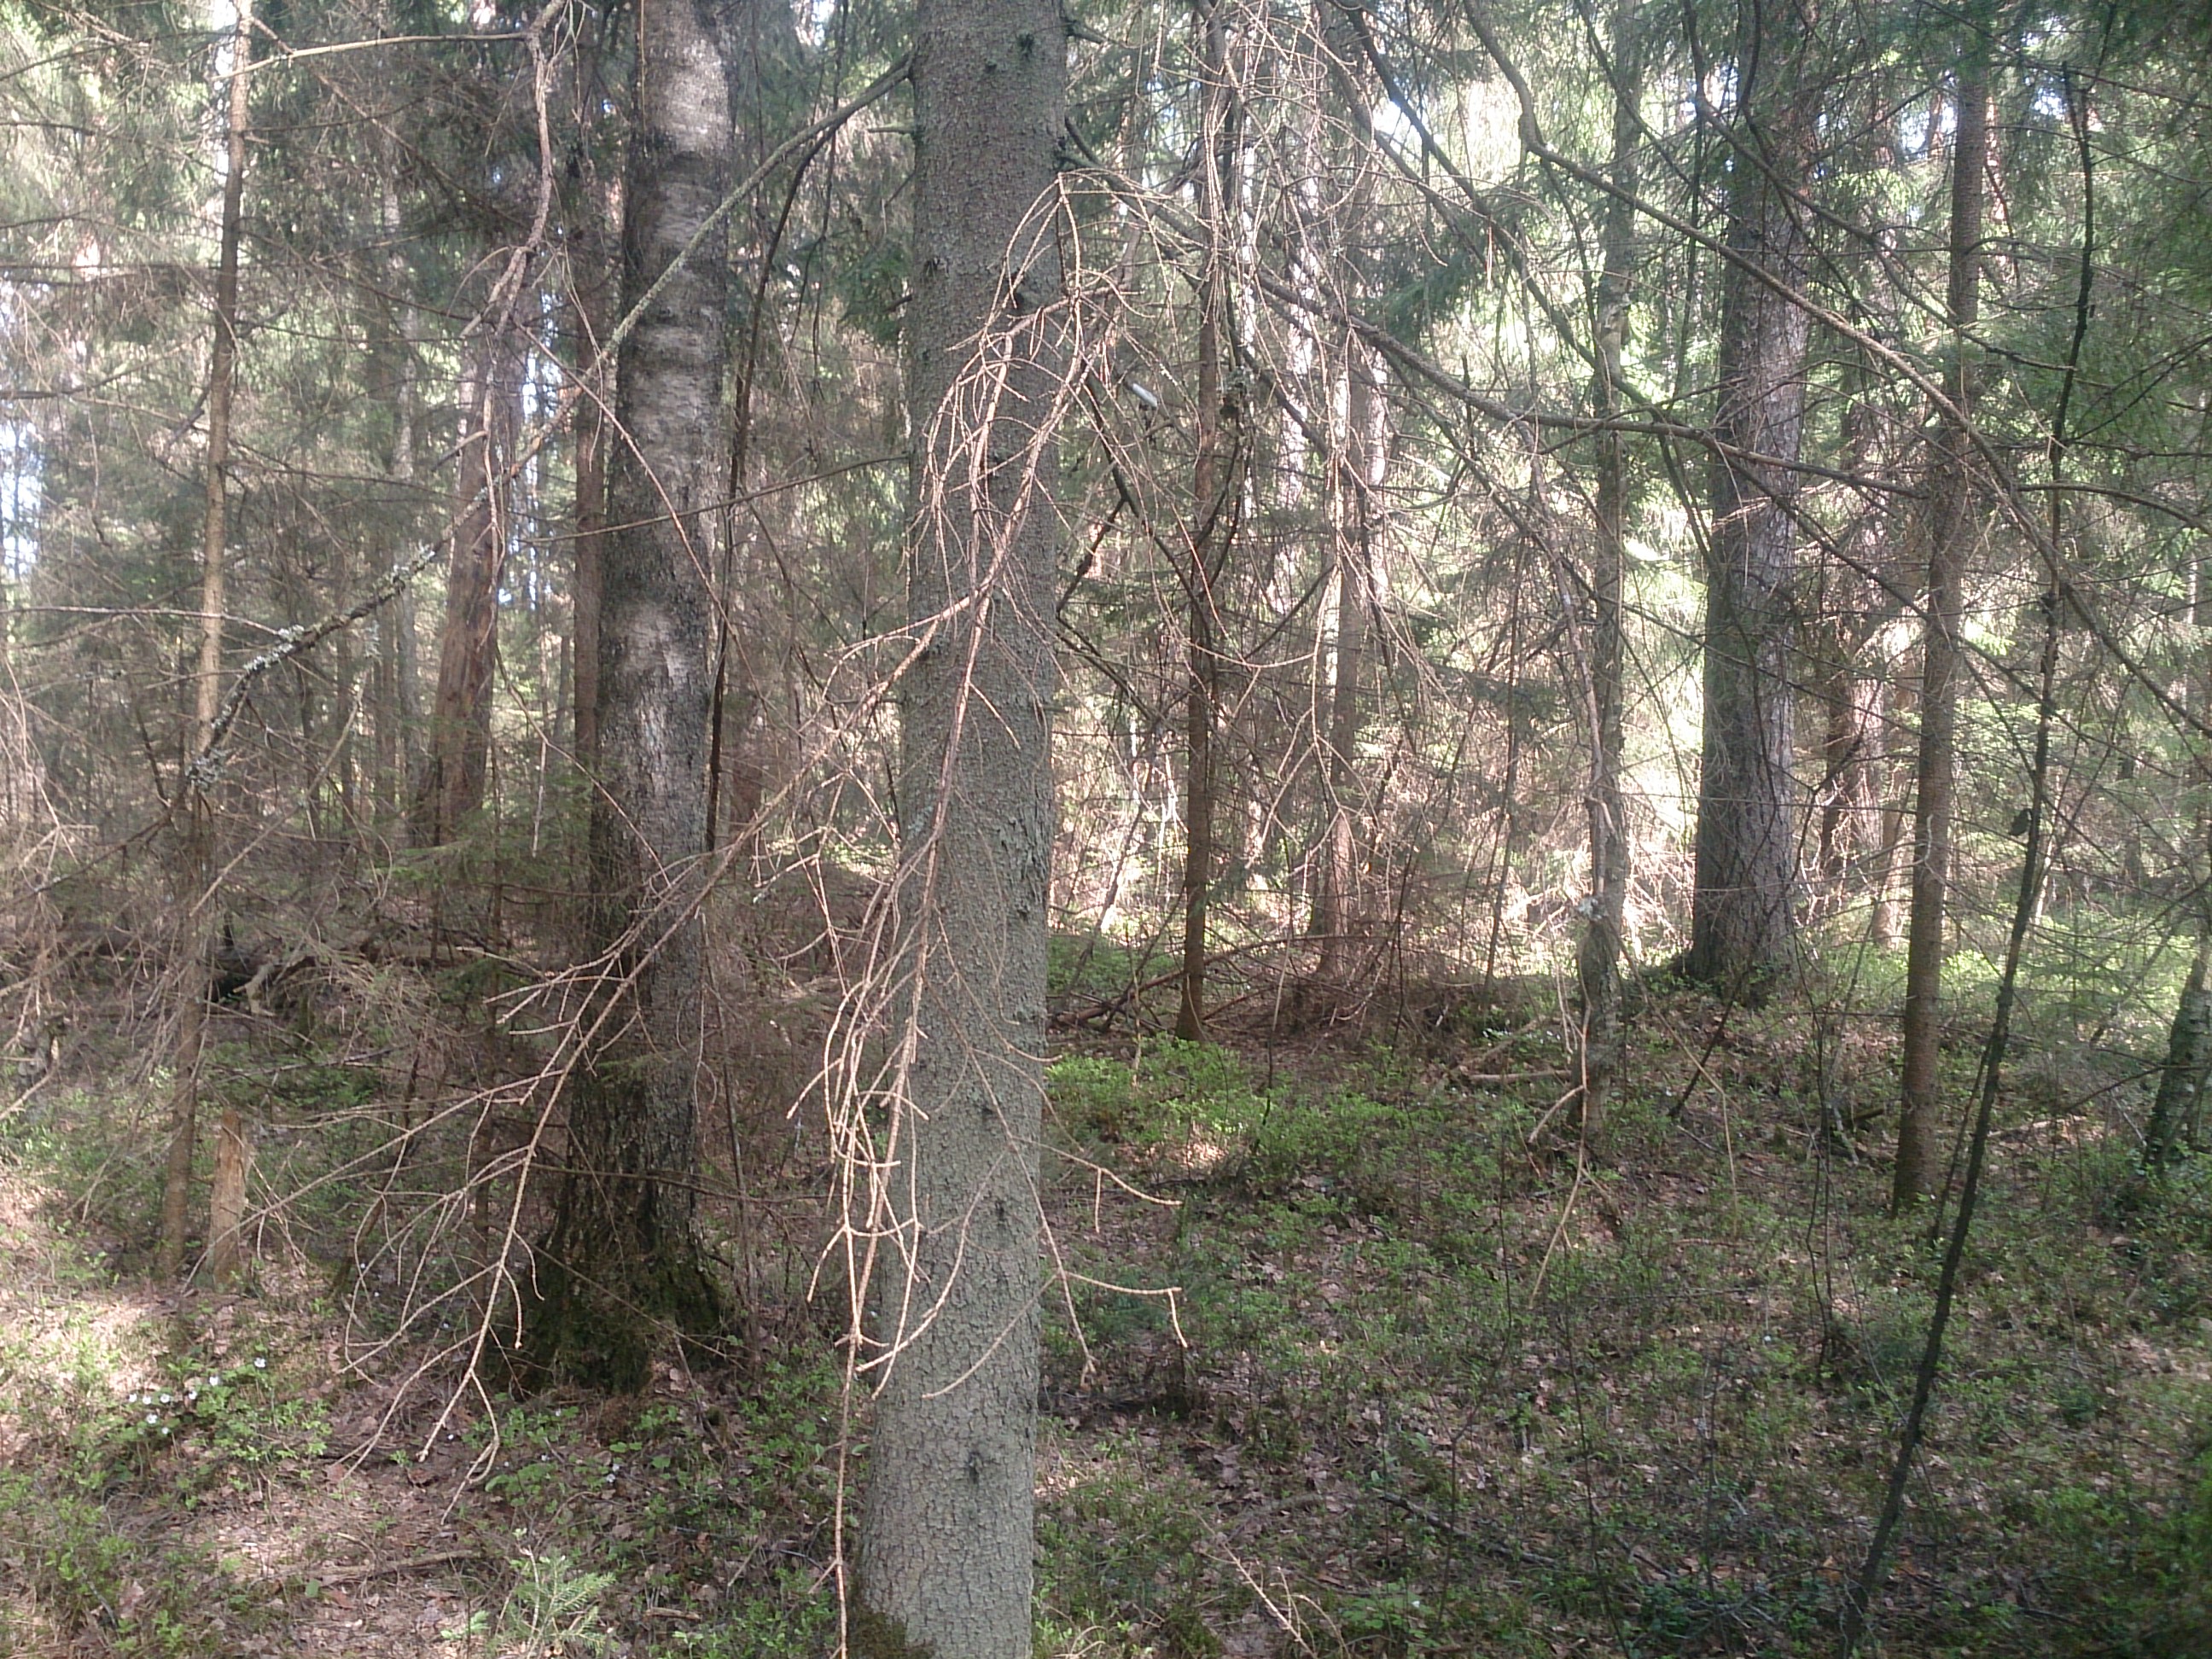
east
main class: Woodland
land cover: Other mixed woodland
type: hemiboreal forest and nemoral coniferous forest and mixed broadleaved-coniferous forest
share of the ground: > 75 %
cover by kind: coniferous forest trees 70 %, broadleaved forest trees 30 %
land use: Forestry
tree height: > 5 m
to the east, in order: Other mixed woodland
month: May
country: LV
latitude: 56.7955
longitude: 24.0844
